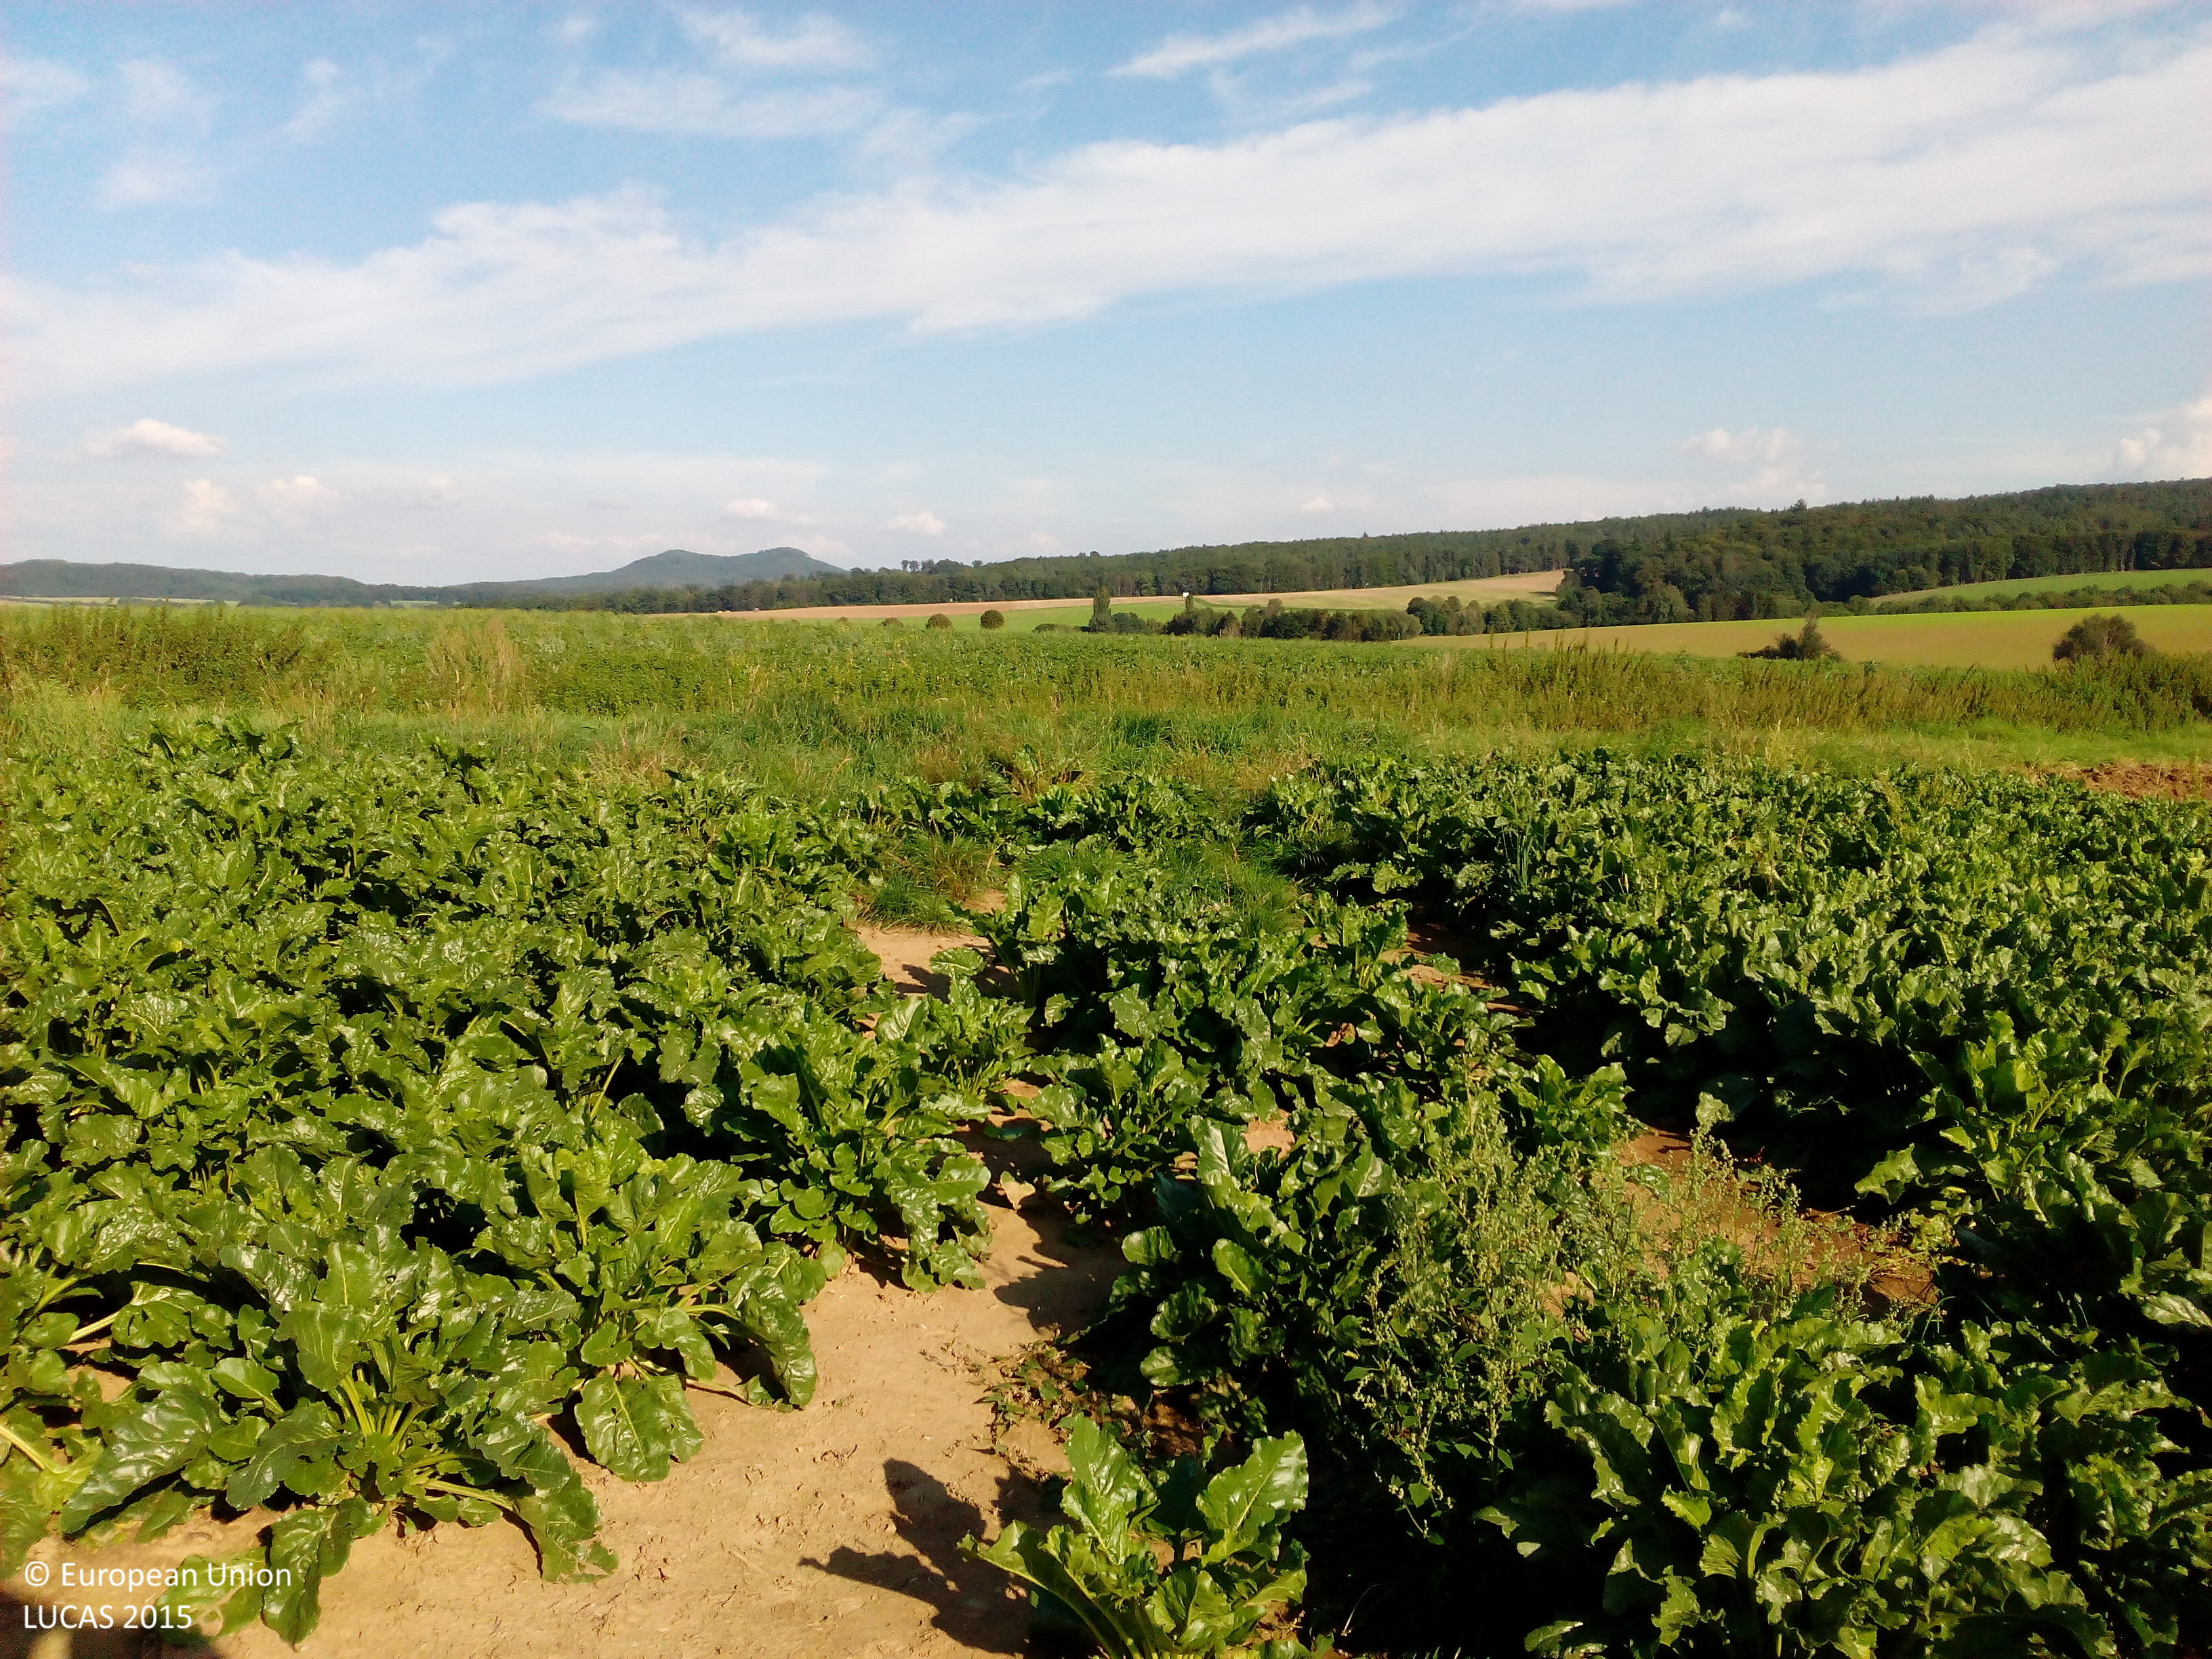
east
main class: Cropland
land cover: Sugar beet
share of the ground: > 75 %
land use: Agriculture (excluding fallow land and kitchen gardens)
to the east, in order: Sugar beet; Grass margins; Tracks; Grass margins; Ditches and canals; Shruby margins; Sugar beet
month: September
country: DE
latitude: 51.4607
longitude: 9.9568
